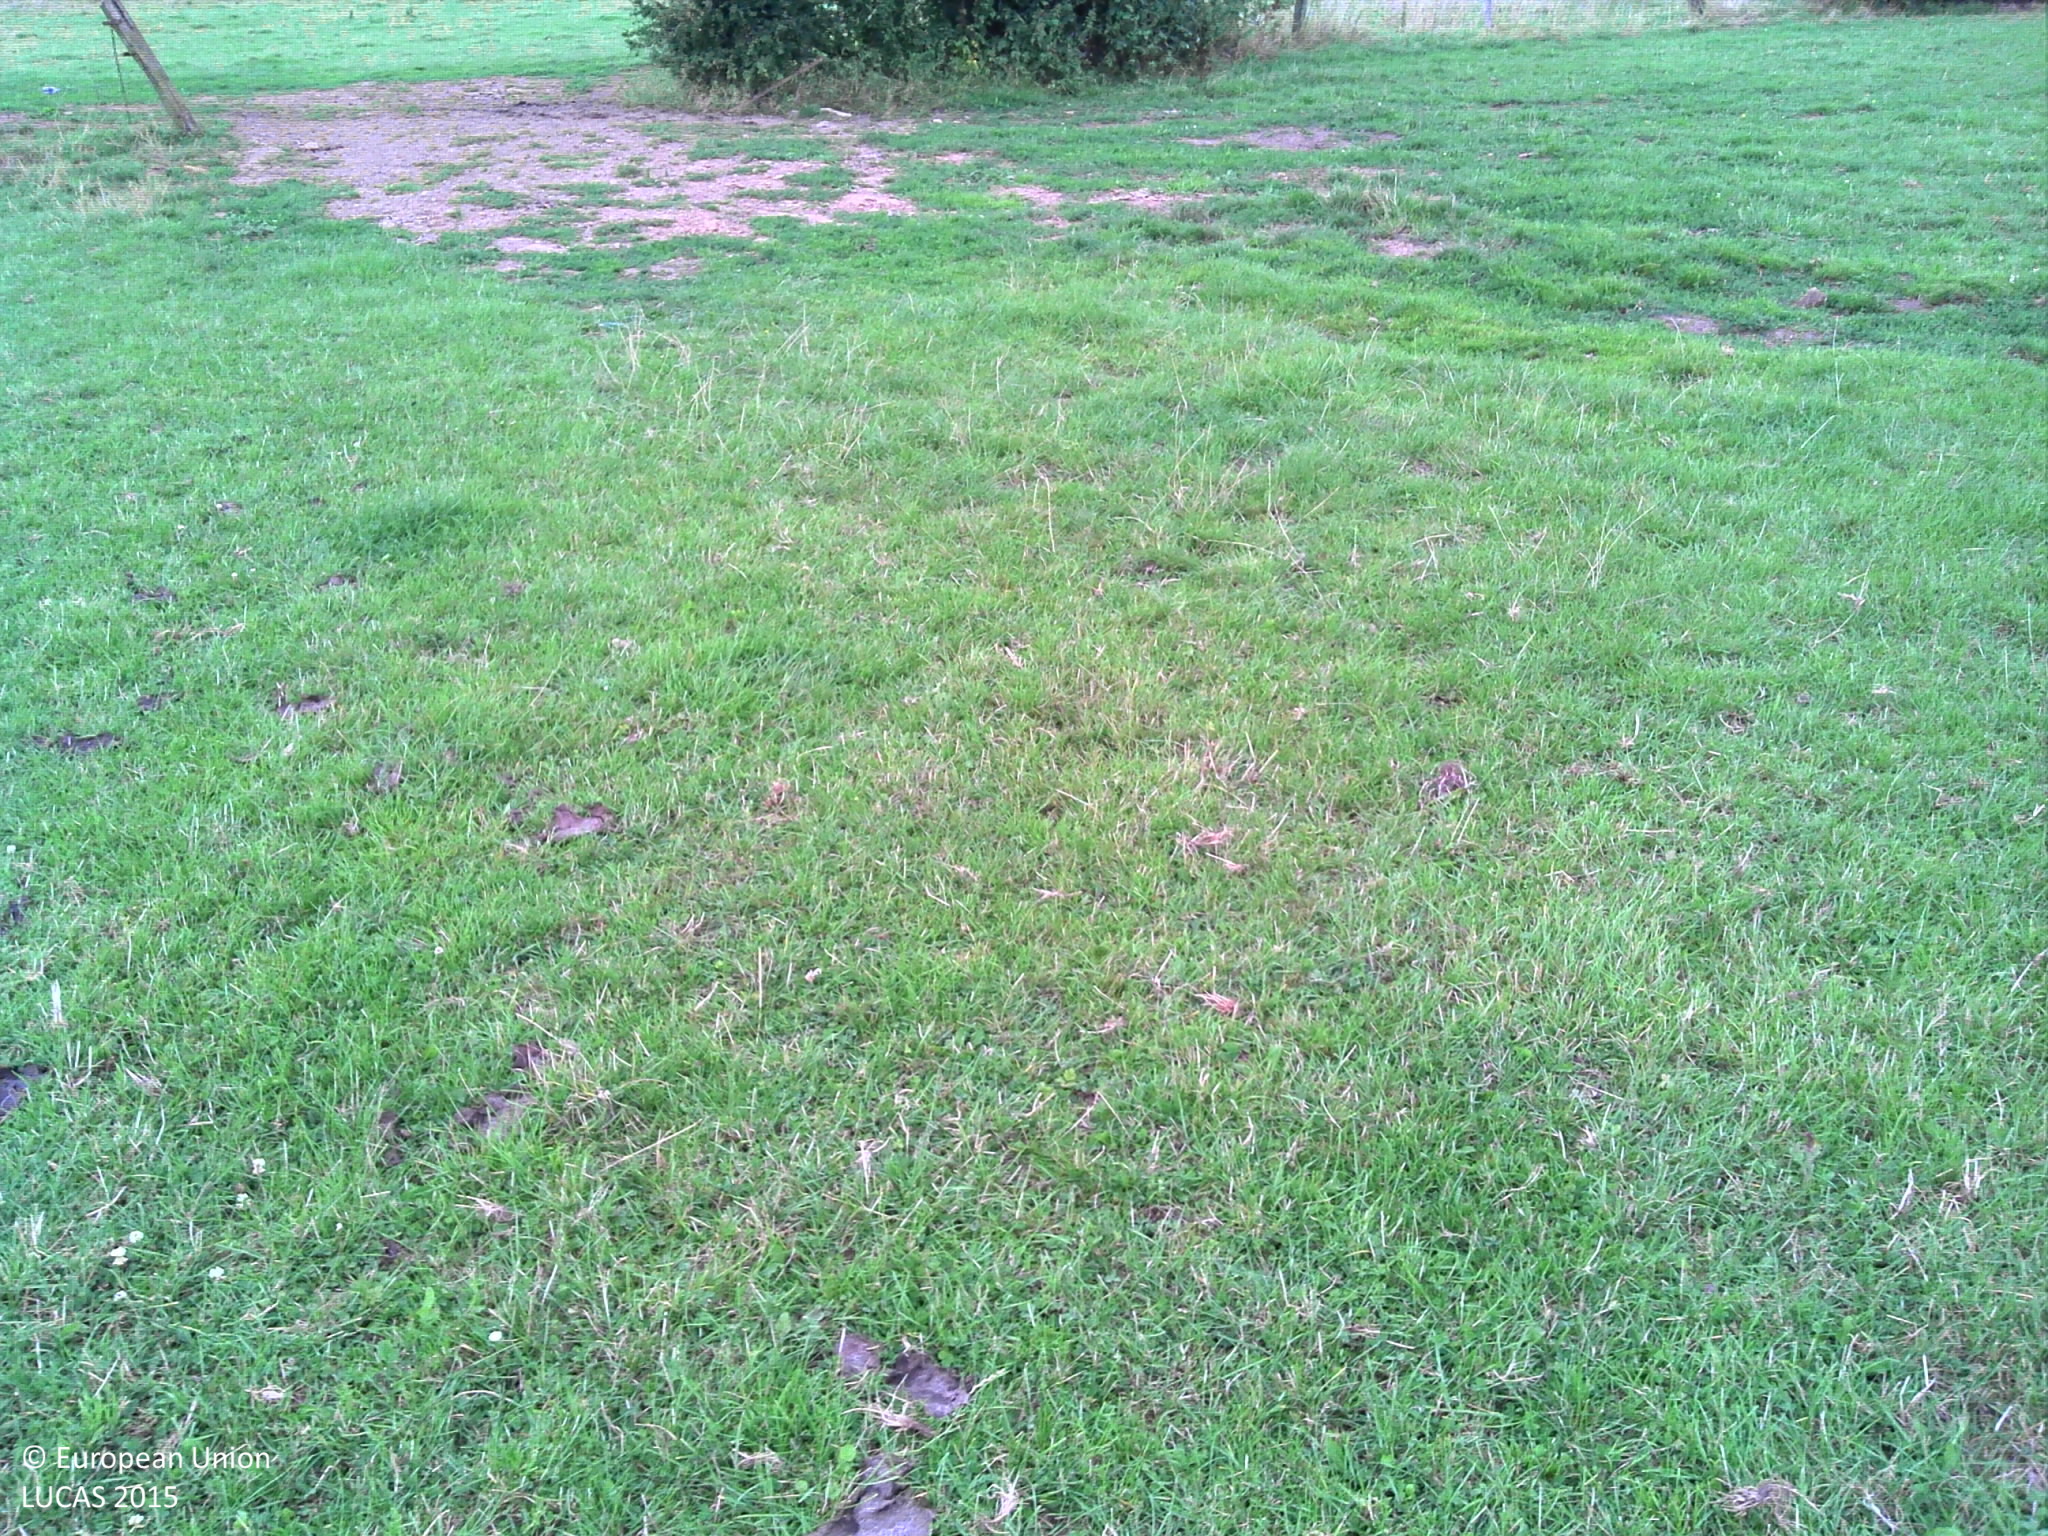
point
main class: Grassland
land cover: Grassland without tree/shrub cover
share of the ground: > 75 %
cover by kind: herbaceous plants 100 %
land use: Agriculture (excluding fallow land and kitchen gardens)
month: August
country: FR
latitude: 50.2788
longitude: 4.0023
